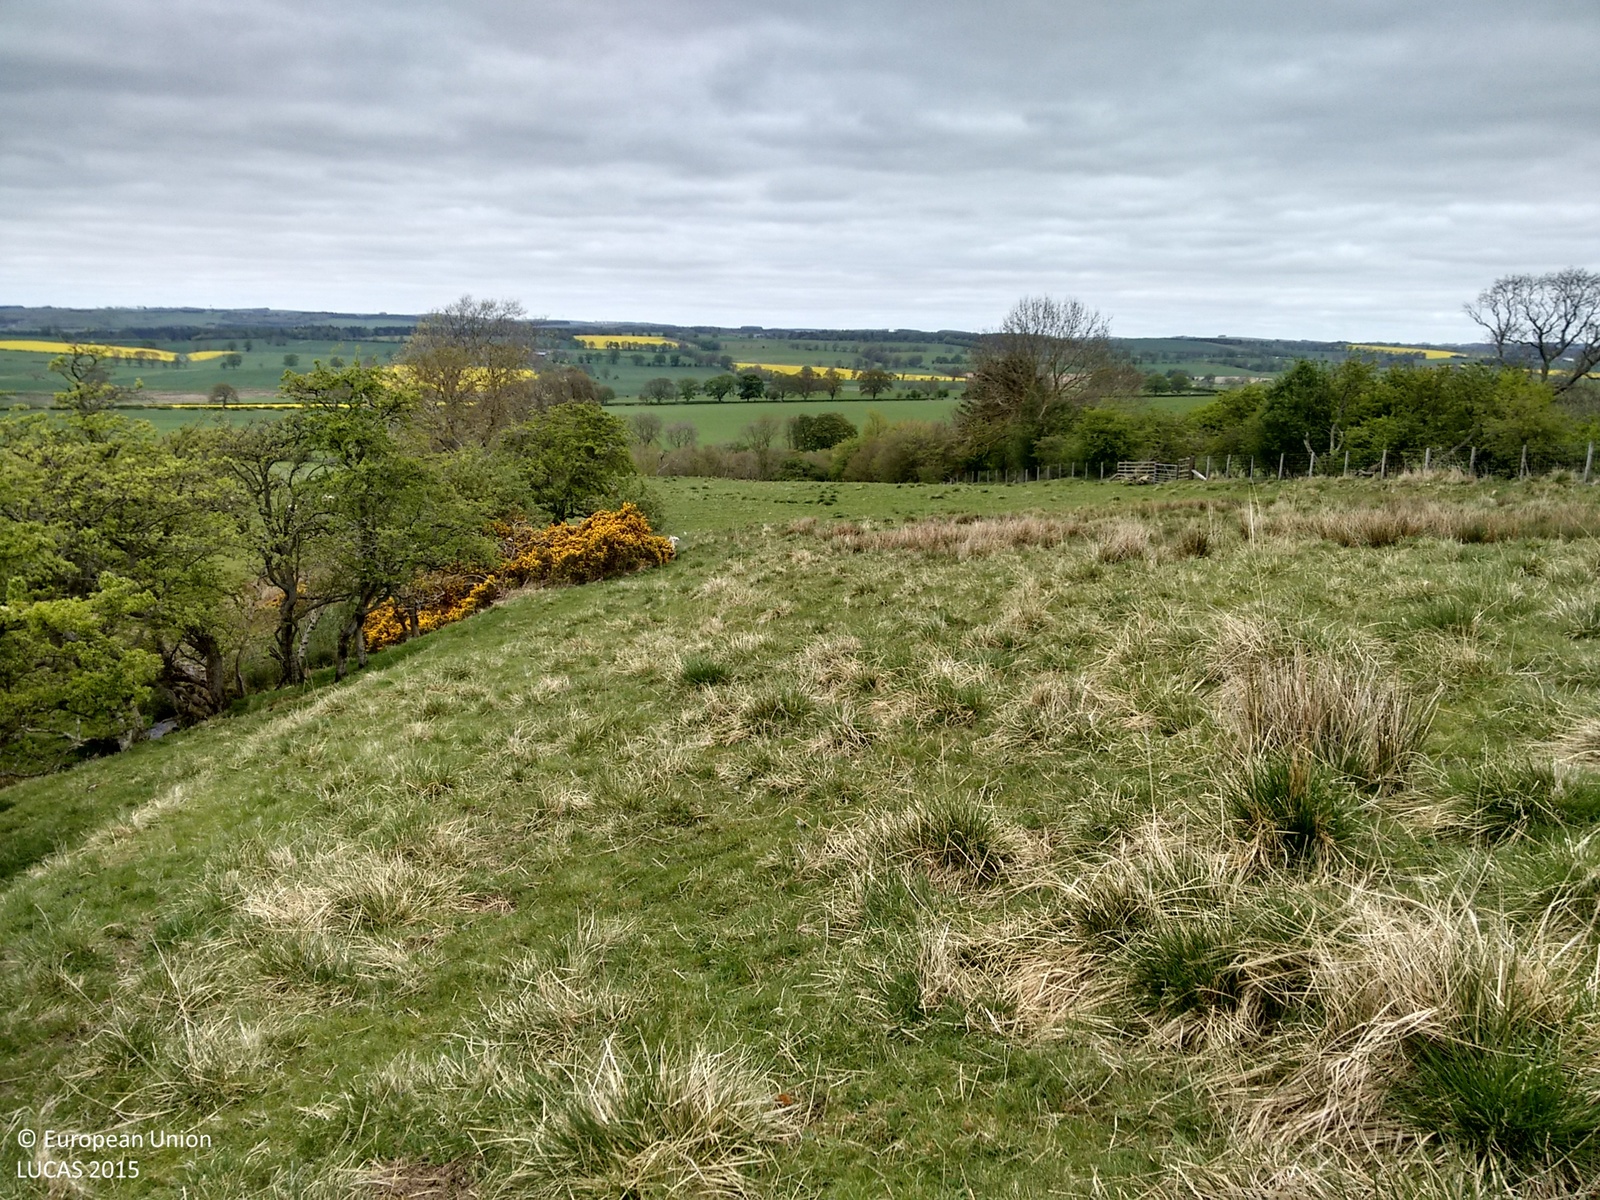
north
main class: Grassland
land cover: Grassland without tree/shrub cover
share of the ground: > 75 %
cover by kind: herbaceous plants 100 %
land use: Agriculture (excluding fallow land and kitchen gardens)
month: May
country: GB
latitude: 55.0315
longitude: -2.0870
